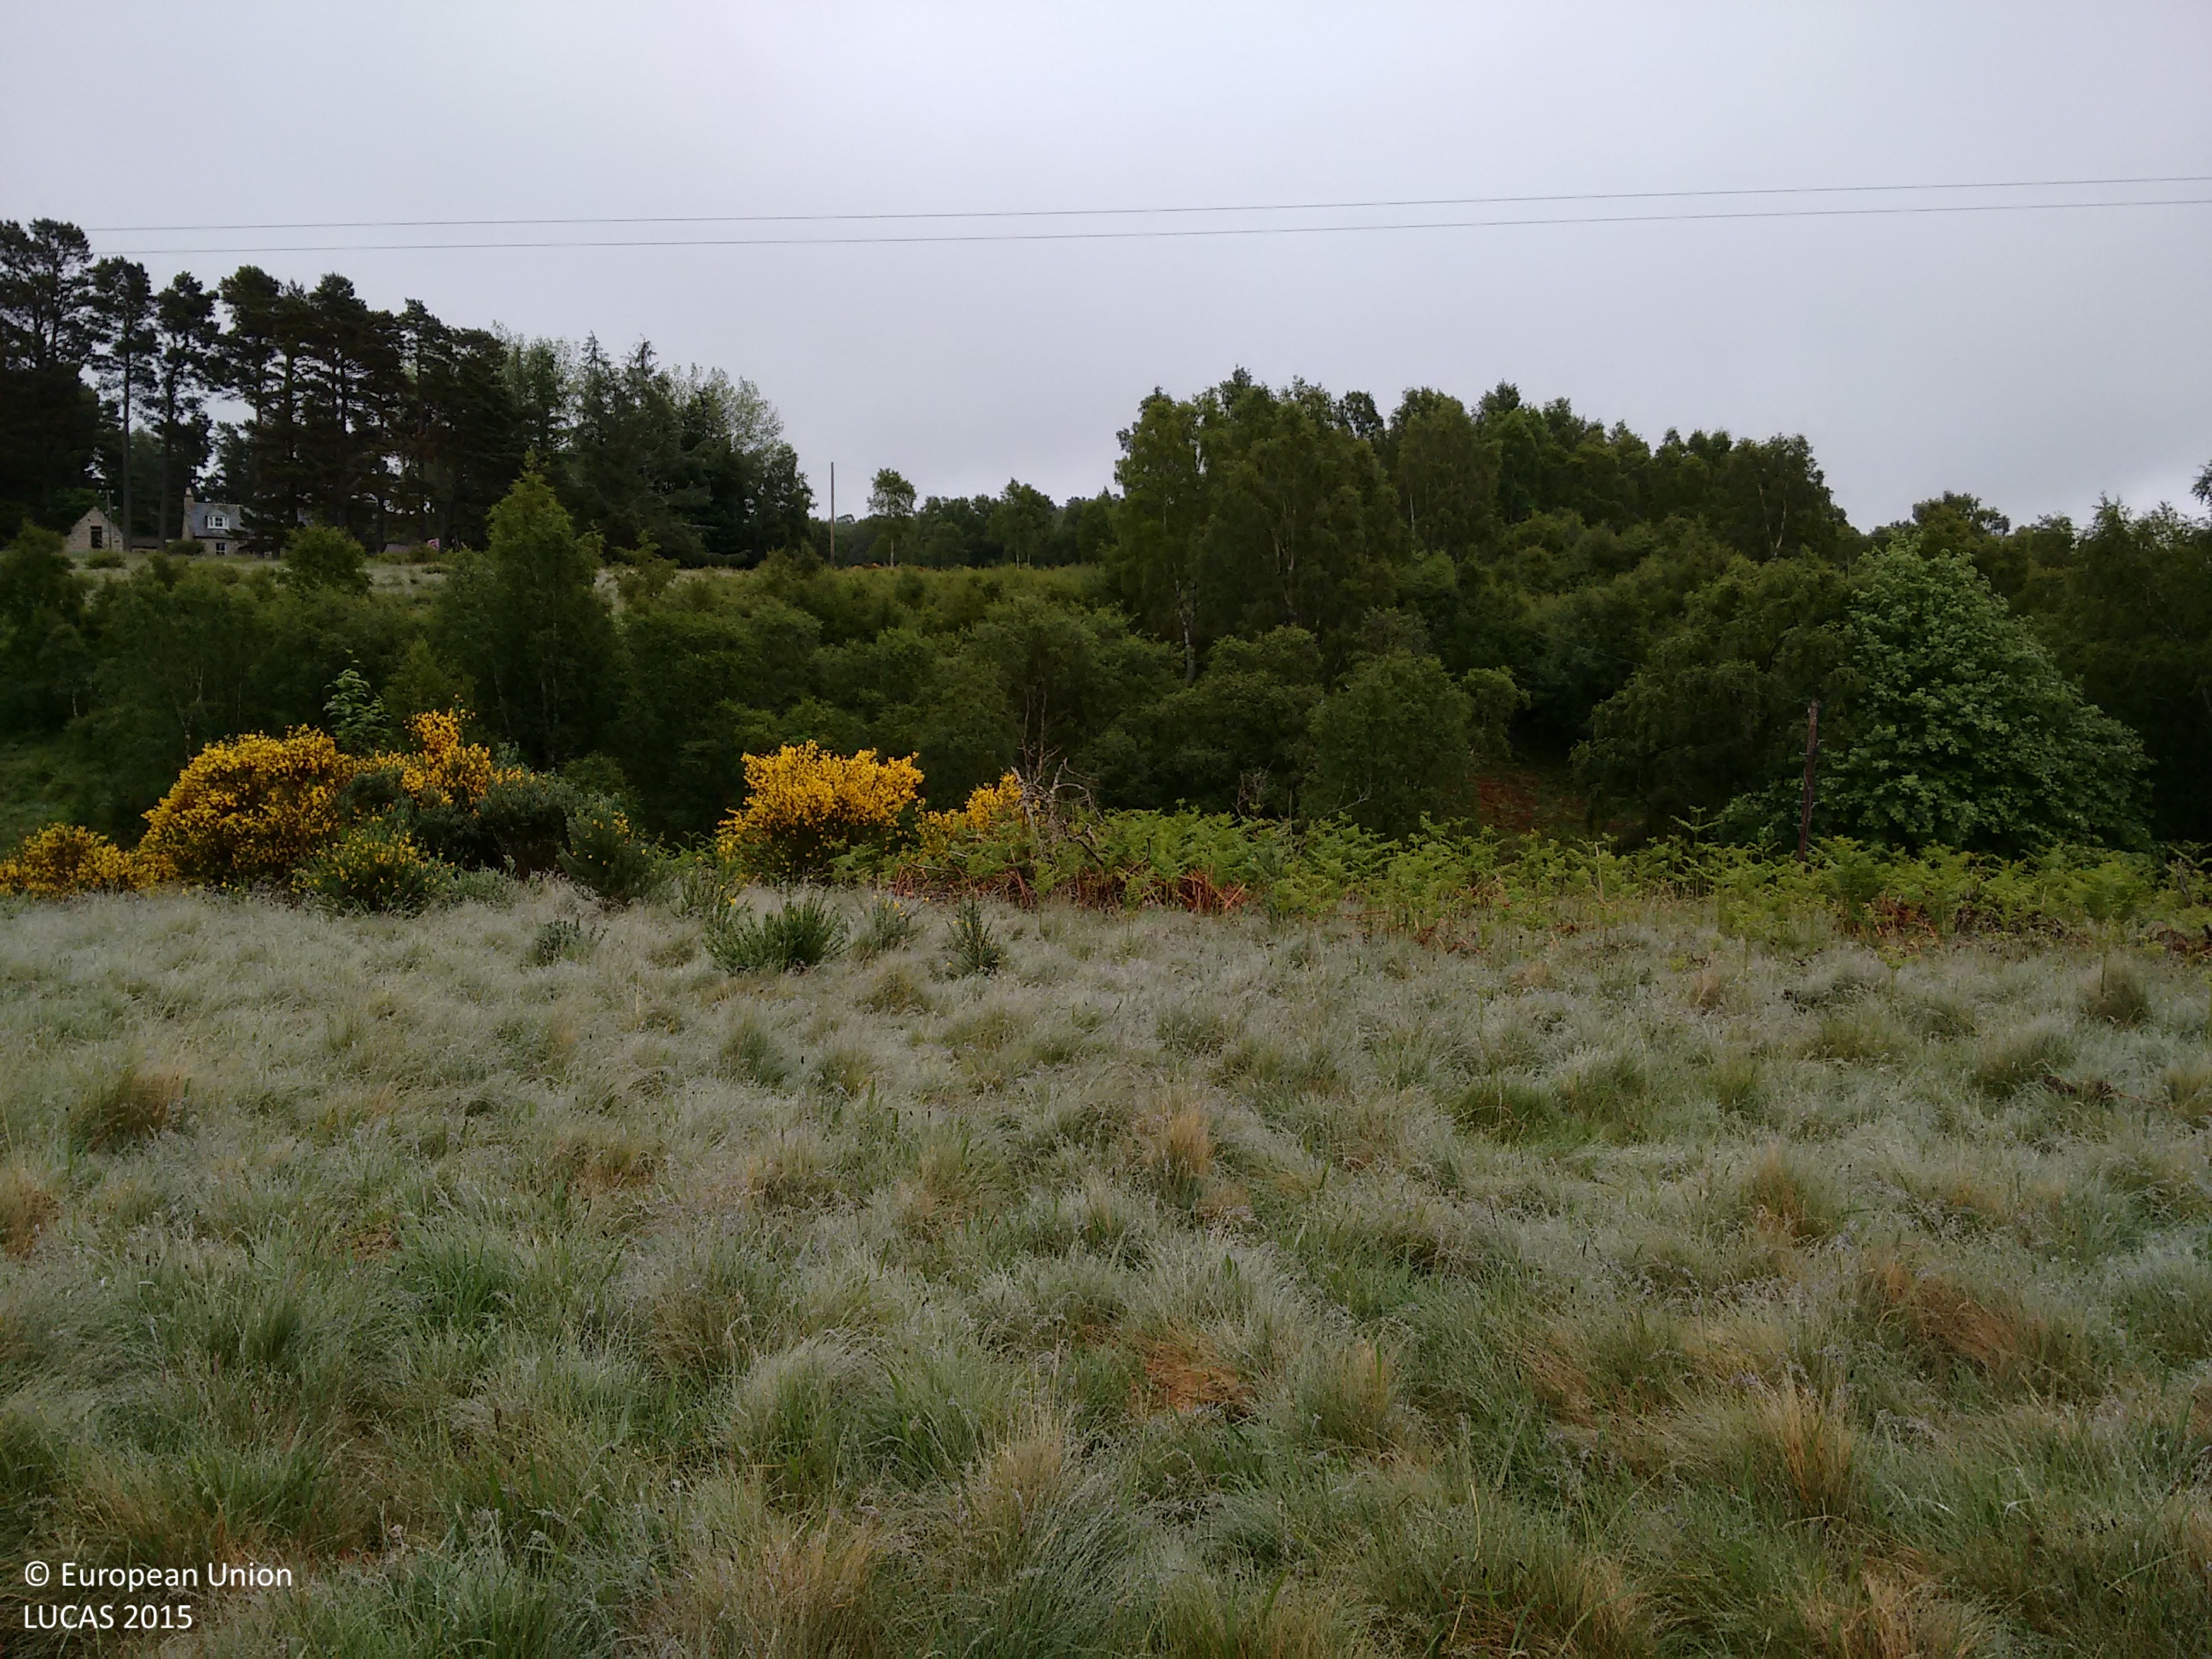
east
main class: Grassland
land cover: Grassland without tree/shrub cover
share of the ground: > 75 %
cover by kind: herbaceous plants 100 %
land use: Semi-natural and natural areas not in use
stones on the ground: < 10 %
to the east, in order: Grassland without tree/shrub cover; Shrubland without tree cover; Electric lines; Broadleaved woodland; Electric lines; Grassland without tree/shrub cover; Broadleaved woodland; Grassland with sparse tree/shrub cover; Grassland without tree/shrub cover; Shrubland without tree cover; Broadleaved woodland
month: June
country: GB
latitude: 57.0852
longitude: -2.8820
